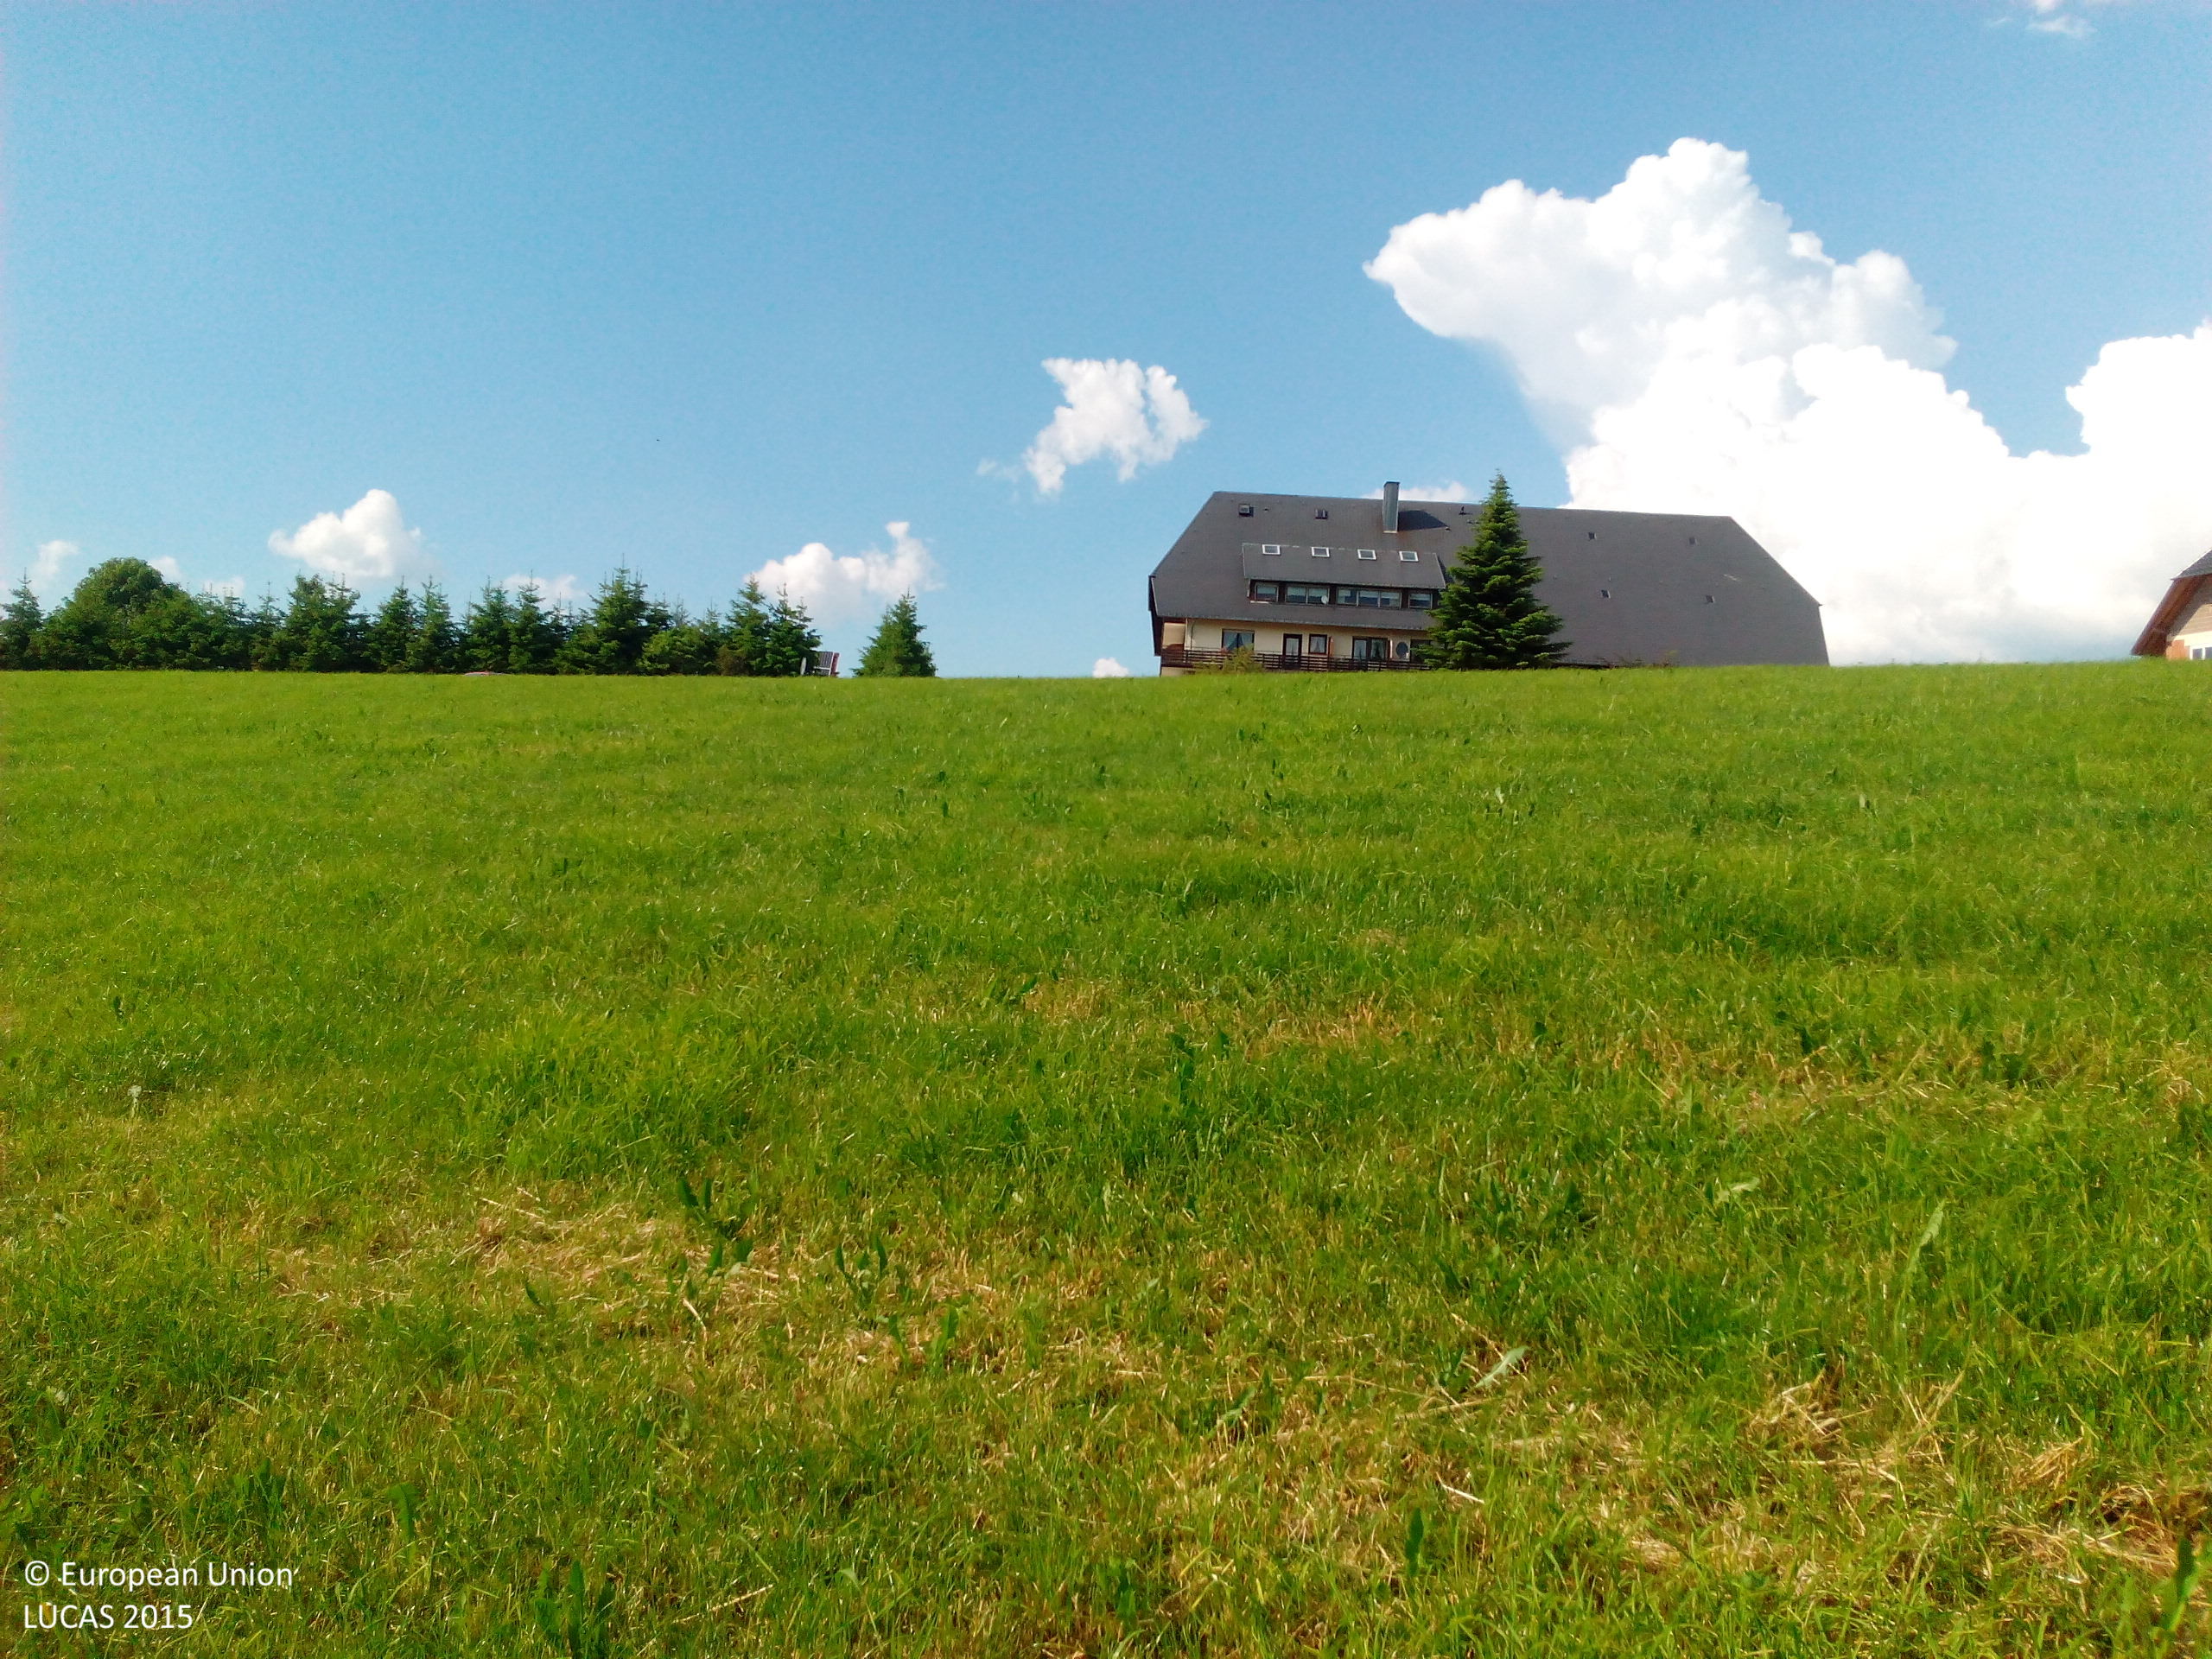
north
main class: Grassland
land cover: Grassland without tree/shrub cover
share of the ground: > 75 %
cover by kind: herbaceous plants 100 %
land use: Agriculture (excluding fallow land and kitchen gardens)
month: June
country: DE
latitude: 47.9734
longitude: 8.1123
